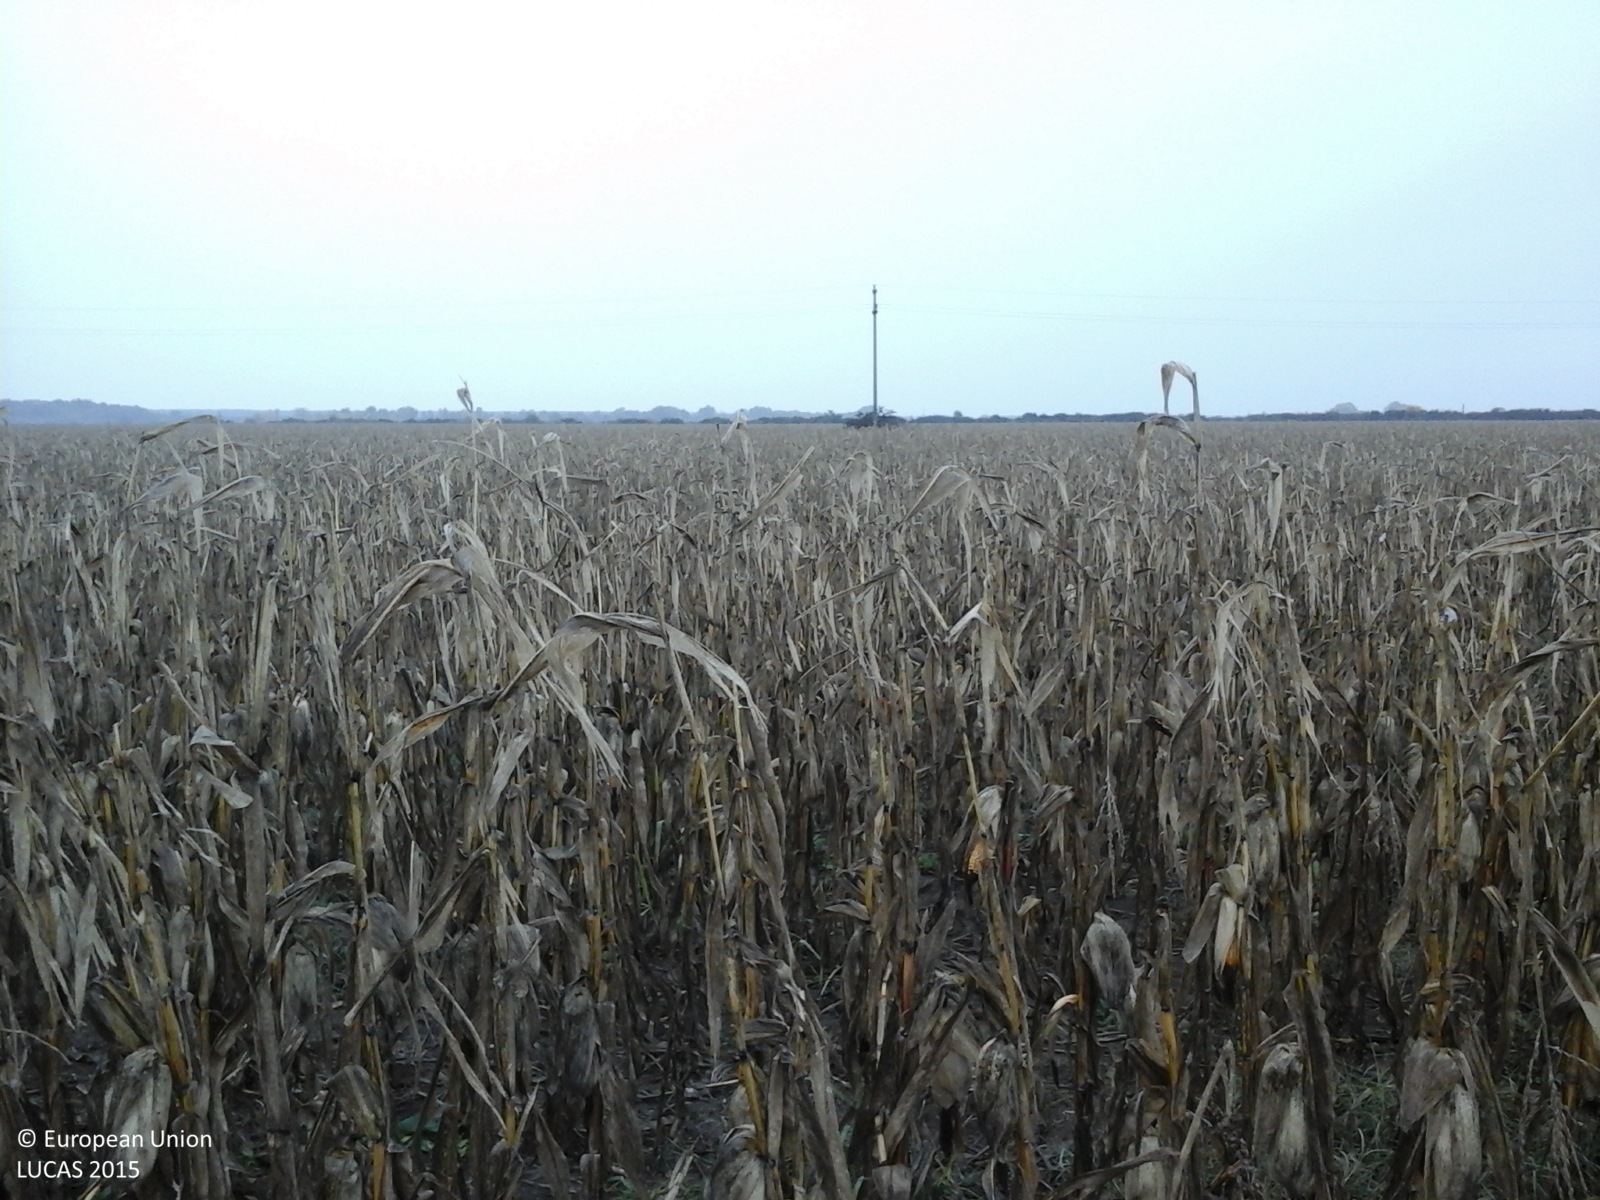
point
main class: Cropland
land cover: Maize
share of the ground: > 75 %
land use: Agriculture (excluding fallow land and kitchen gardens)
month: October
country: RO
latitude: 44.8418
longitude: 26.0094
